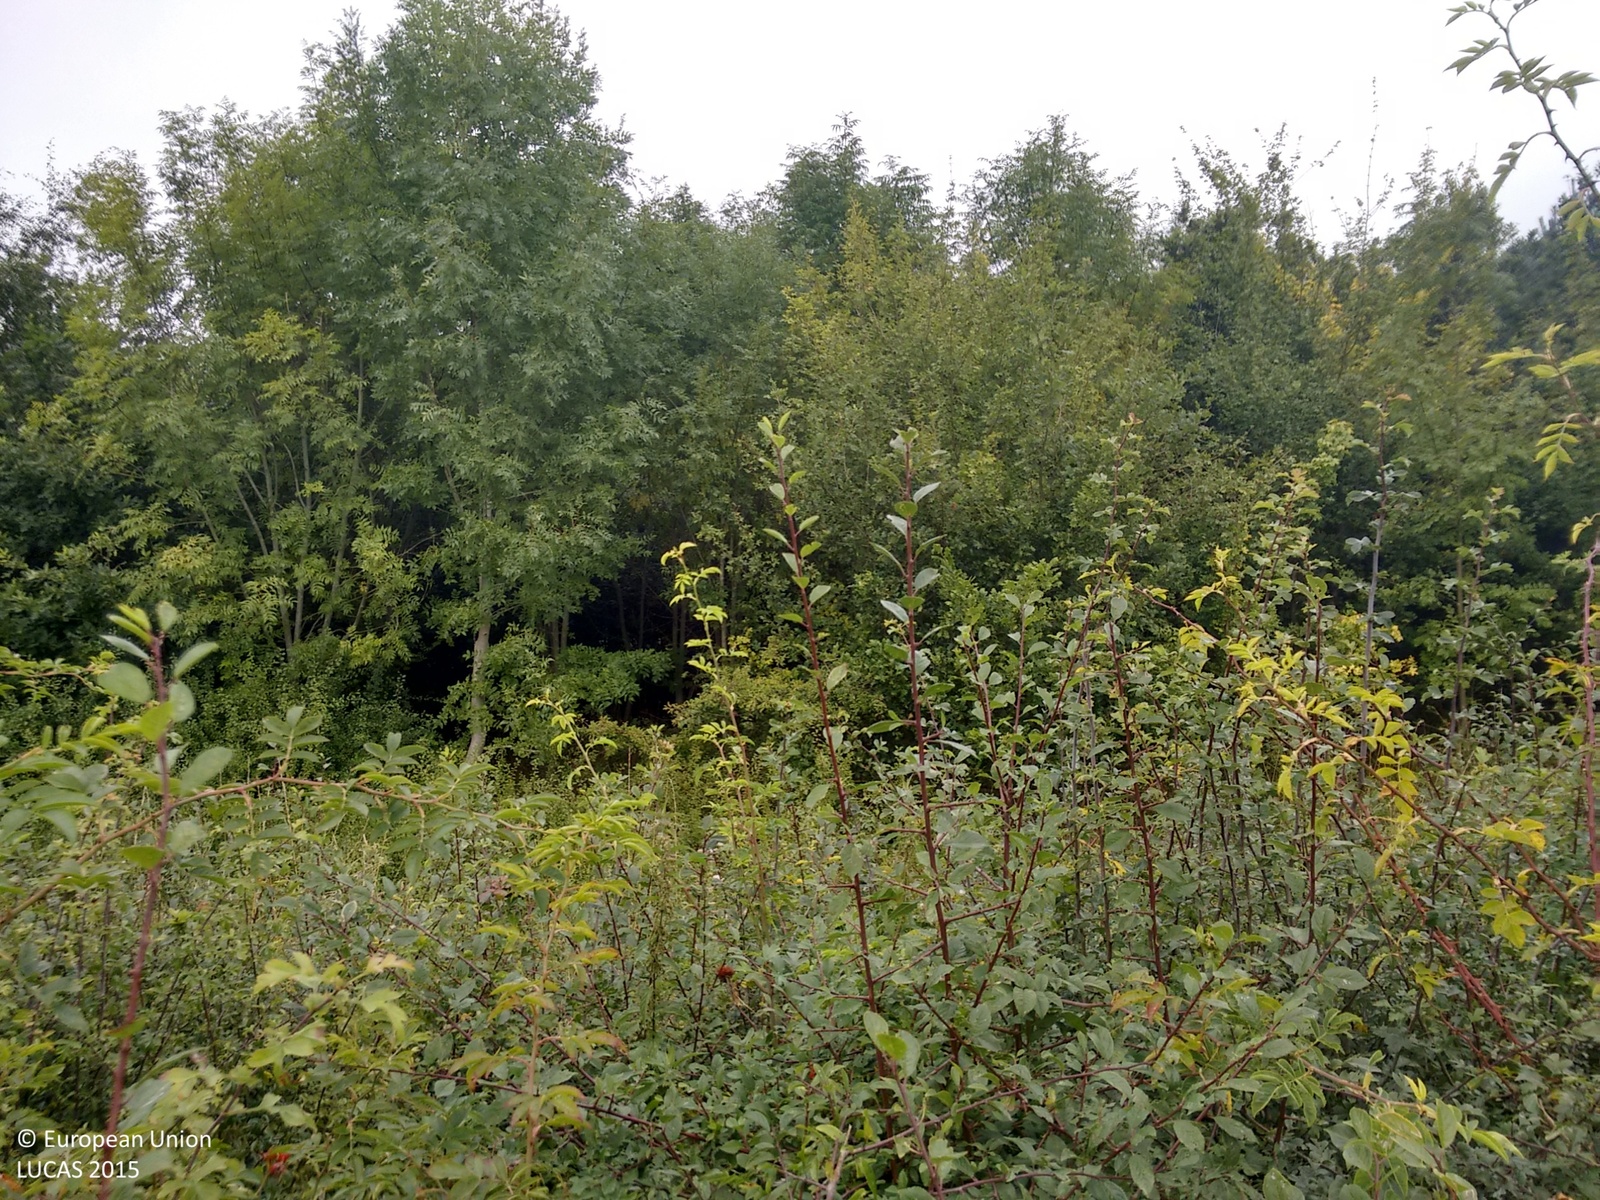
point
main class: Woodland
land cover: Broadleaved woodland
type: mesophytic deciduous forest
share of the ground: > 75 %
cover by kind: broadleaved forest trees 100 %
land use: Forestry
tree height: > 5 m
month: September
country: GB
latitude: 52.7524
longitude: -2.8283
